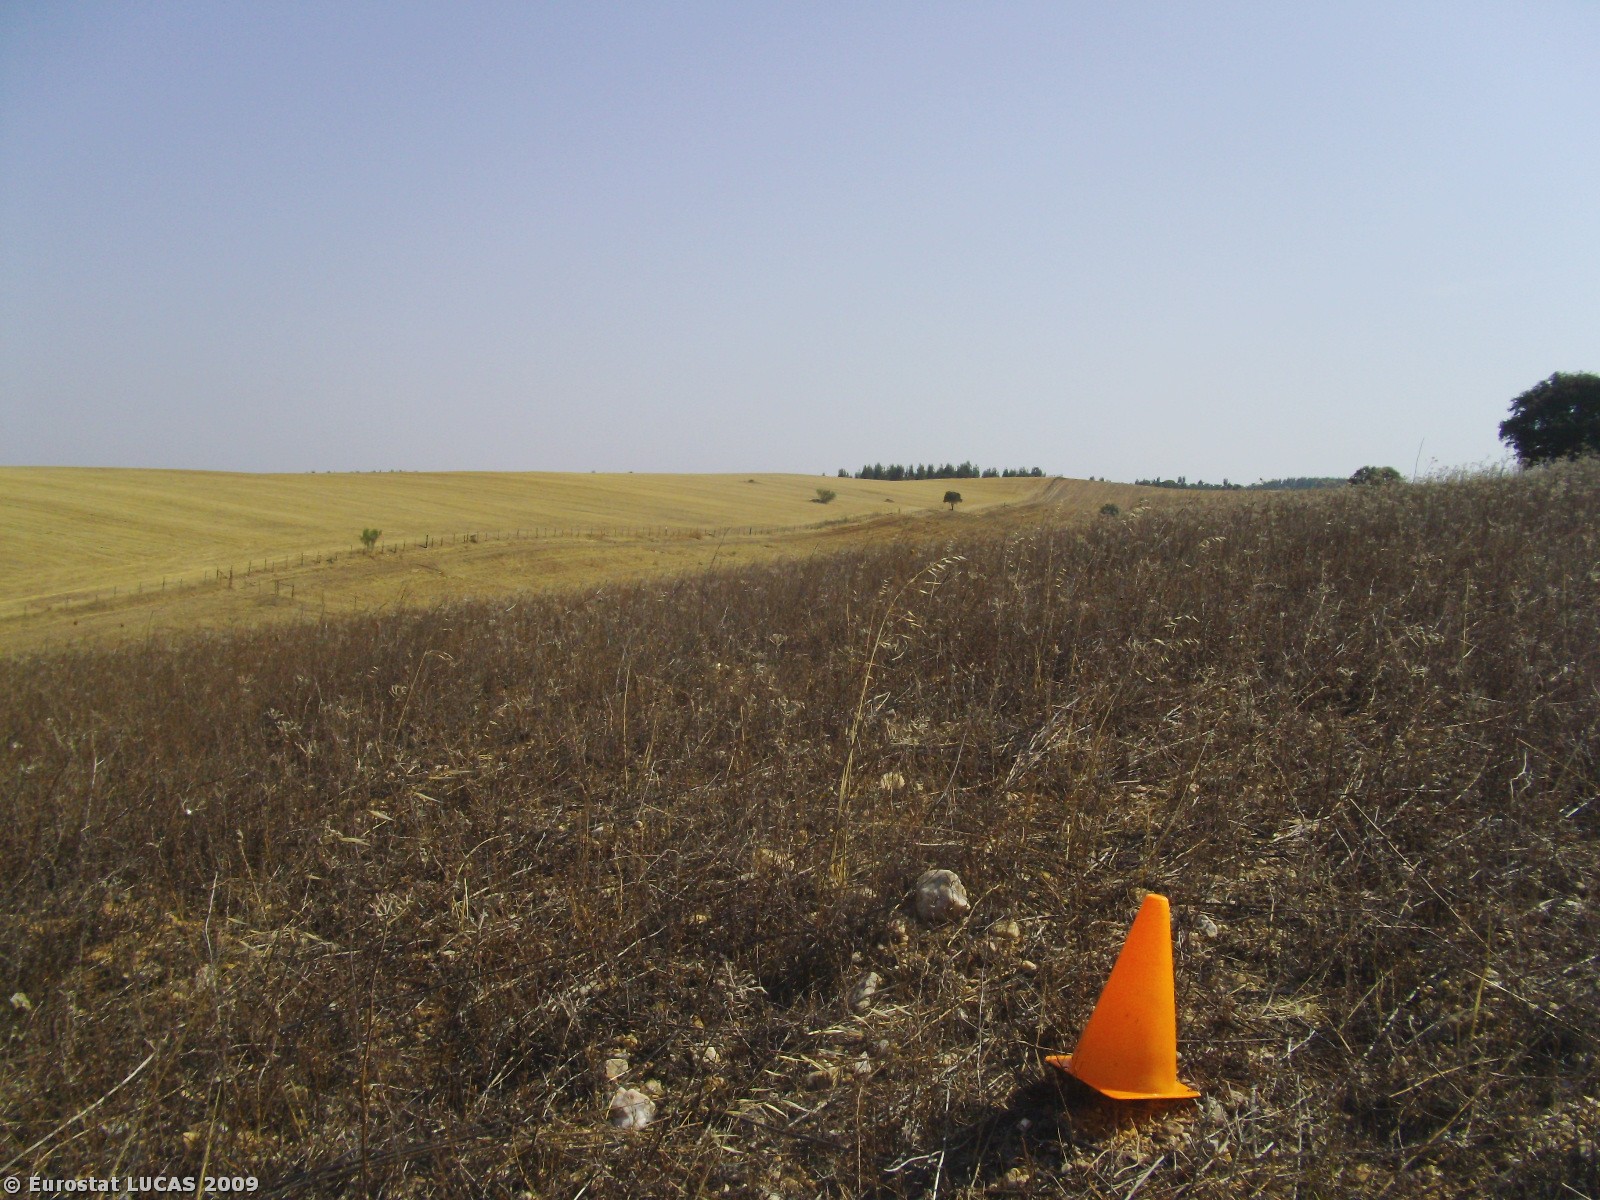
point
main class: Grassland
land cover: Spontaneously vegetated surfaces
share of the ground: 50 - 75 %
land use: Fallow land
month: August
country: PT
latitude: 38.4115
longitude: -7.6557
